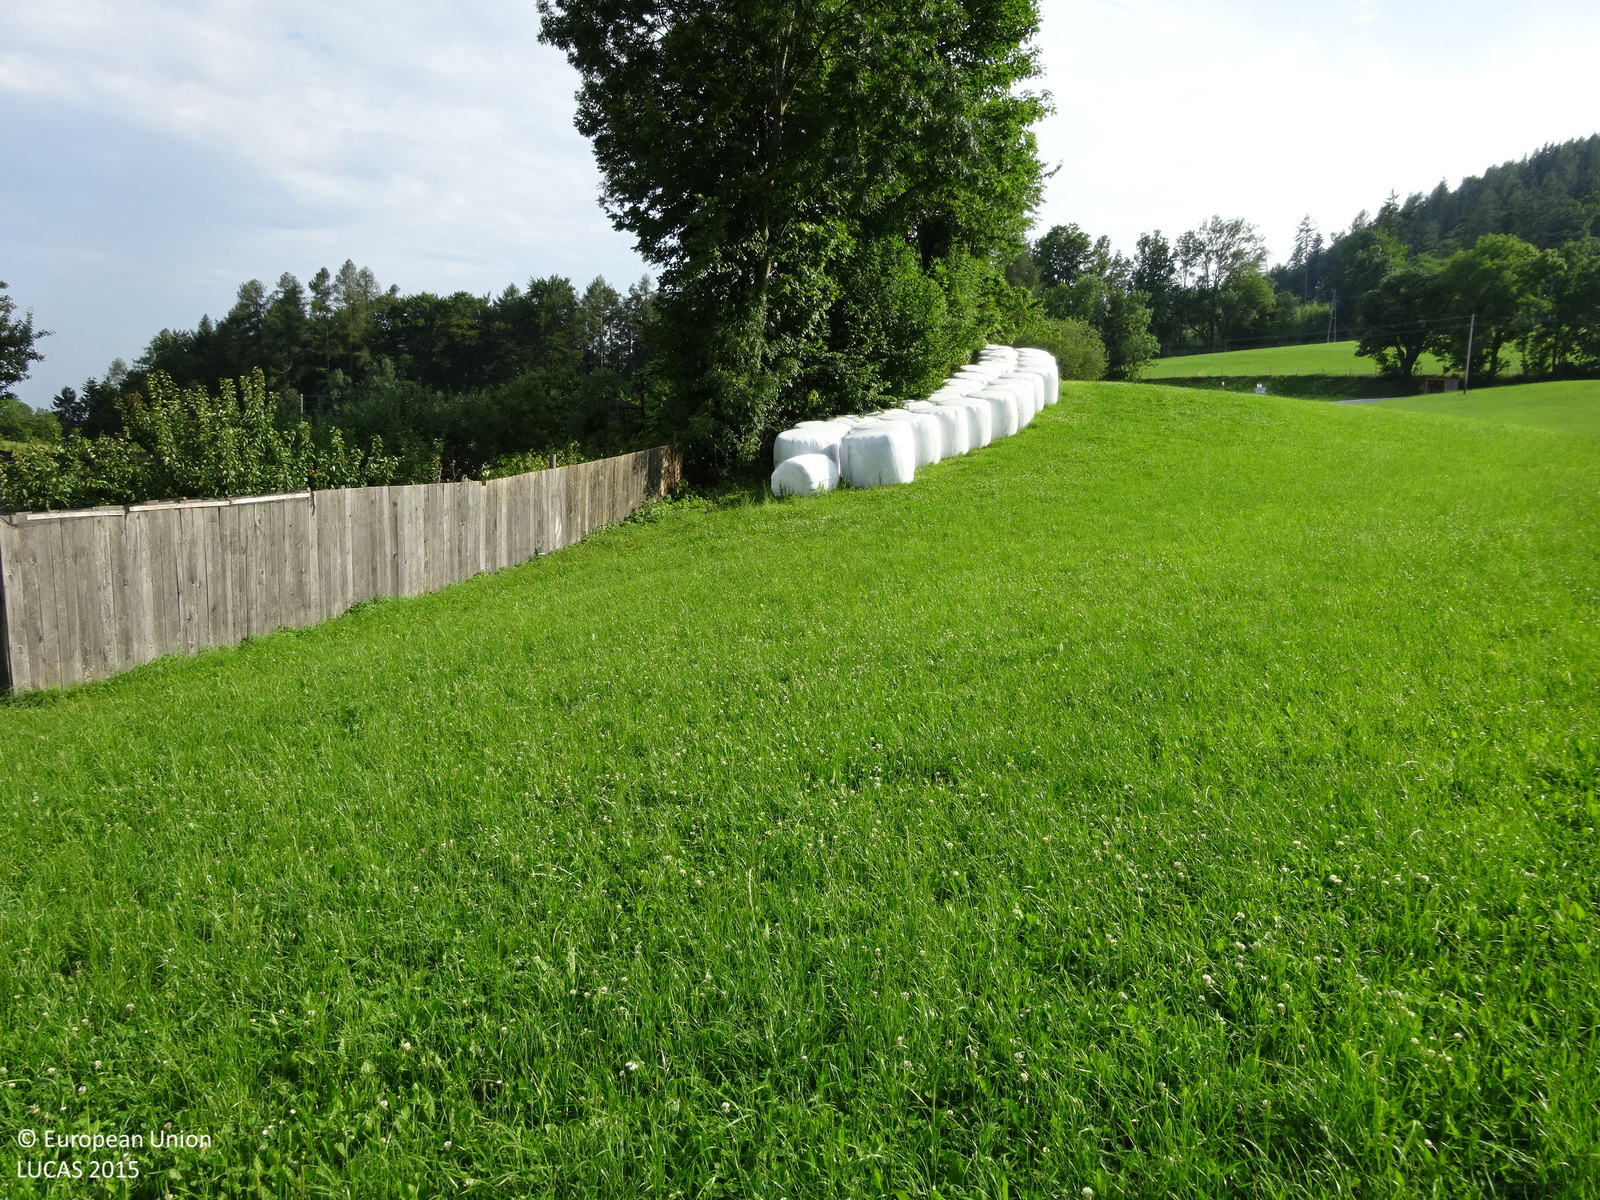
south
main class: Grassland
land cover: Grassland without tree/shrub cover
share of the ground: > 75 %
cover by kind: herbaceous plants 100 %
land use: Agriculture (excluding fallow land and kitchen gardens)
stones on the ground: < 10 %
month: July
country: AT
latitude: 47.2657
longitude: 15.6708
